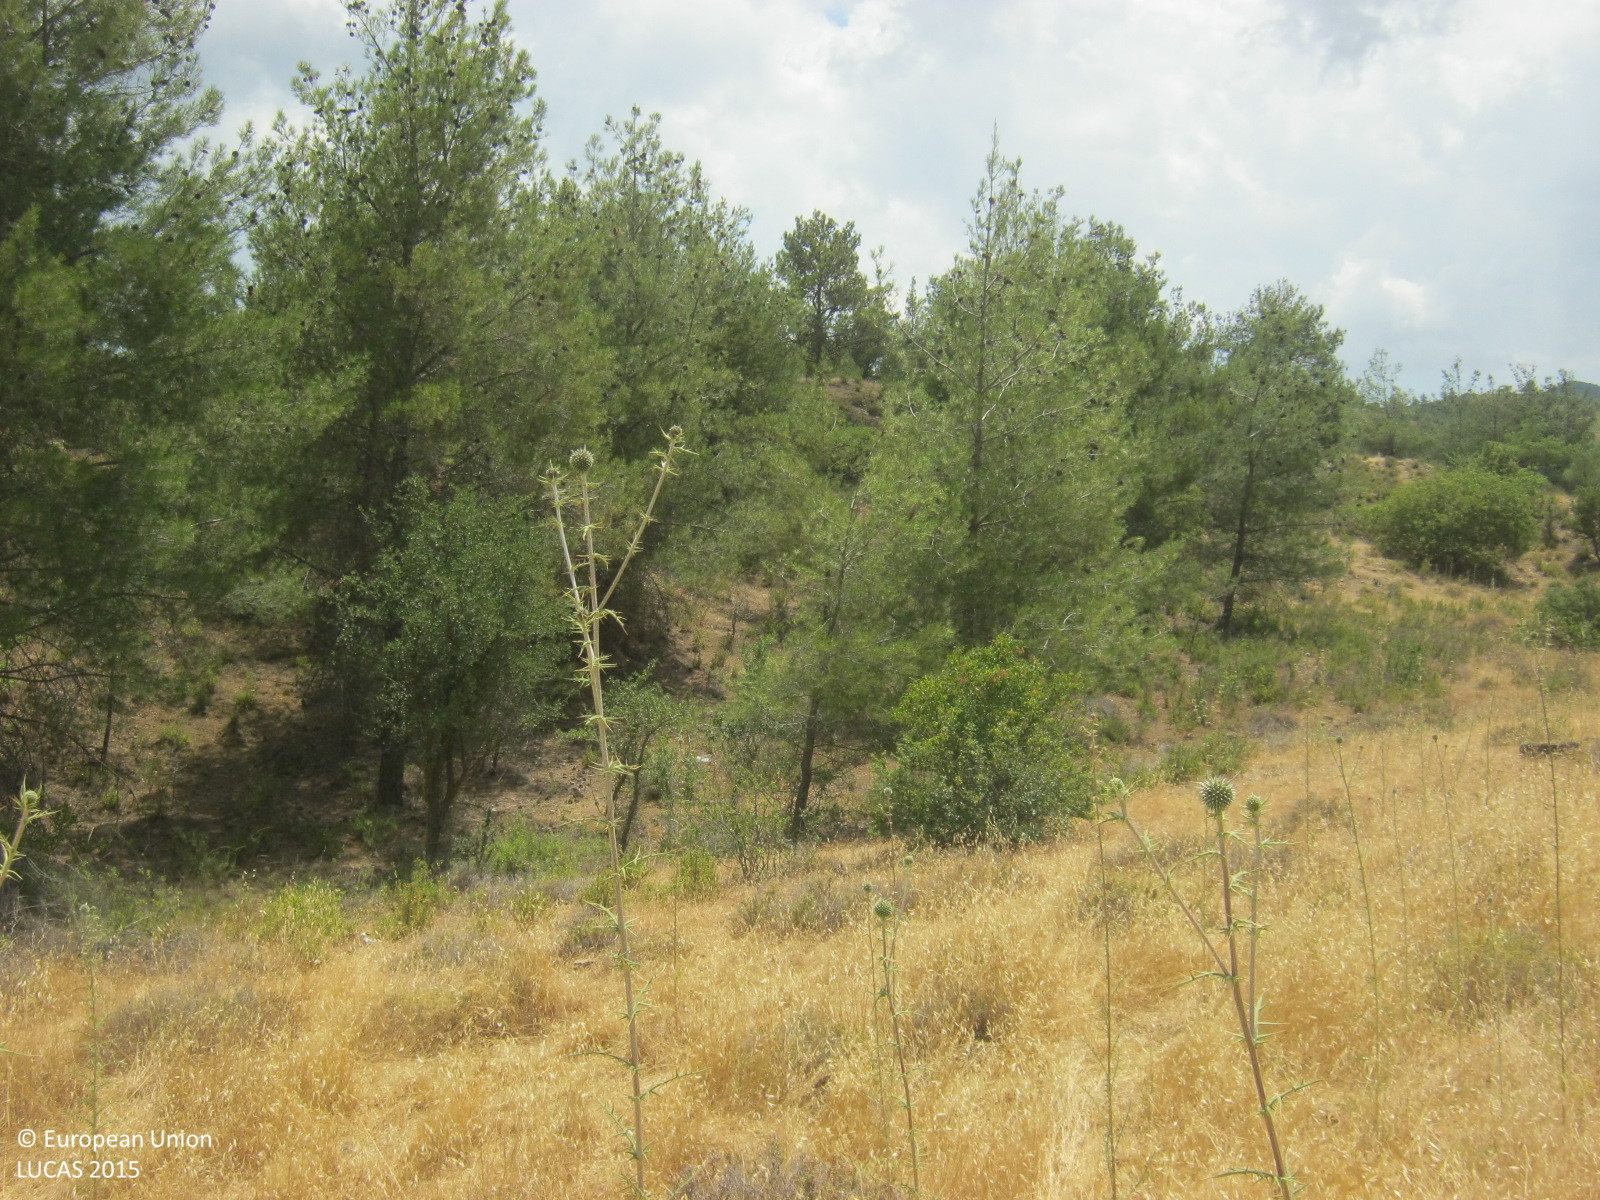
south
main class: Grassland
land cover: Grassland with sparse tree/shrub cover
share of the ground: > 75 %
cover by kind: herbaceous plants 90 %, coniferous forest trees 5 %, shrubs 5 %
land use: Semi-natural and natural areas not in use
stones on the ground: 10 - 25 %
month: June
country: CY
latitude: 34.9871
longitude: 33.1978
